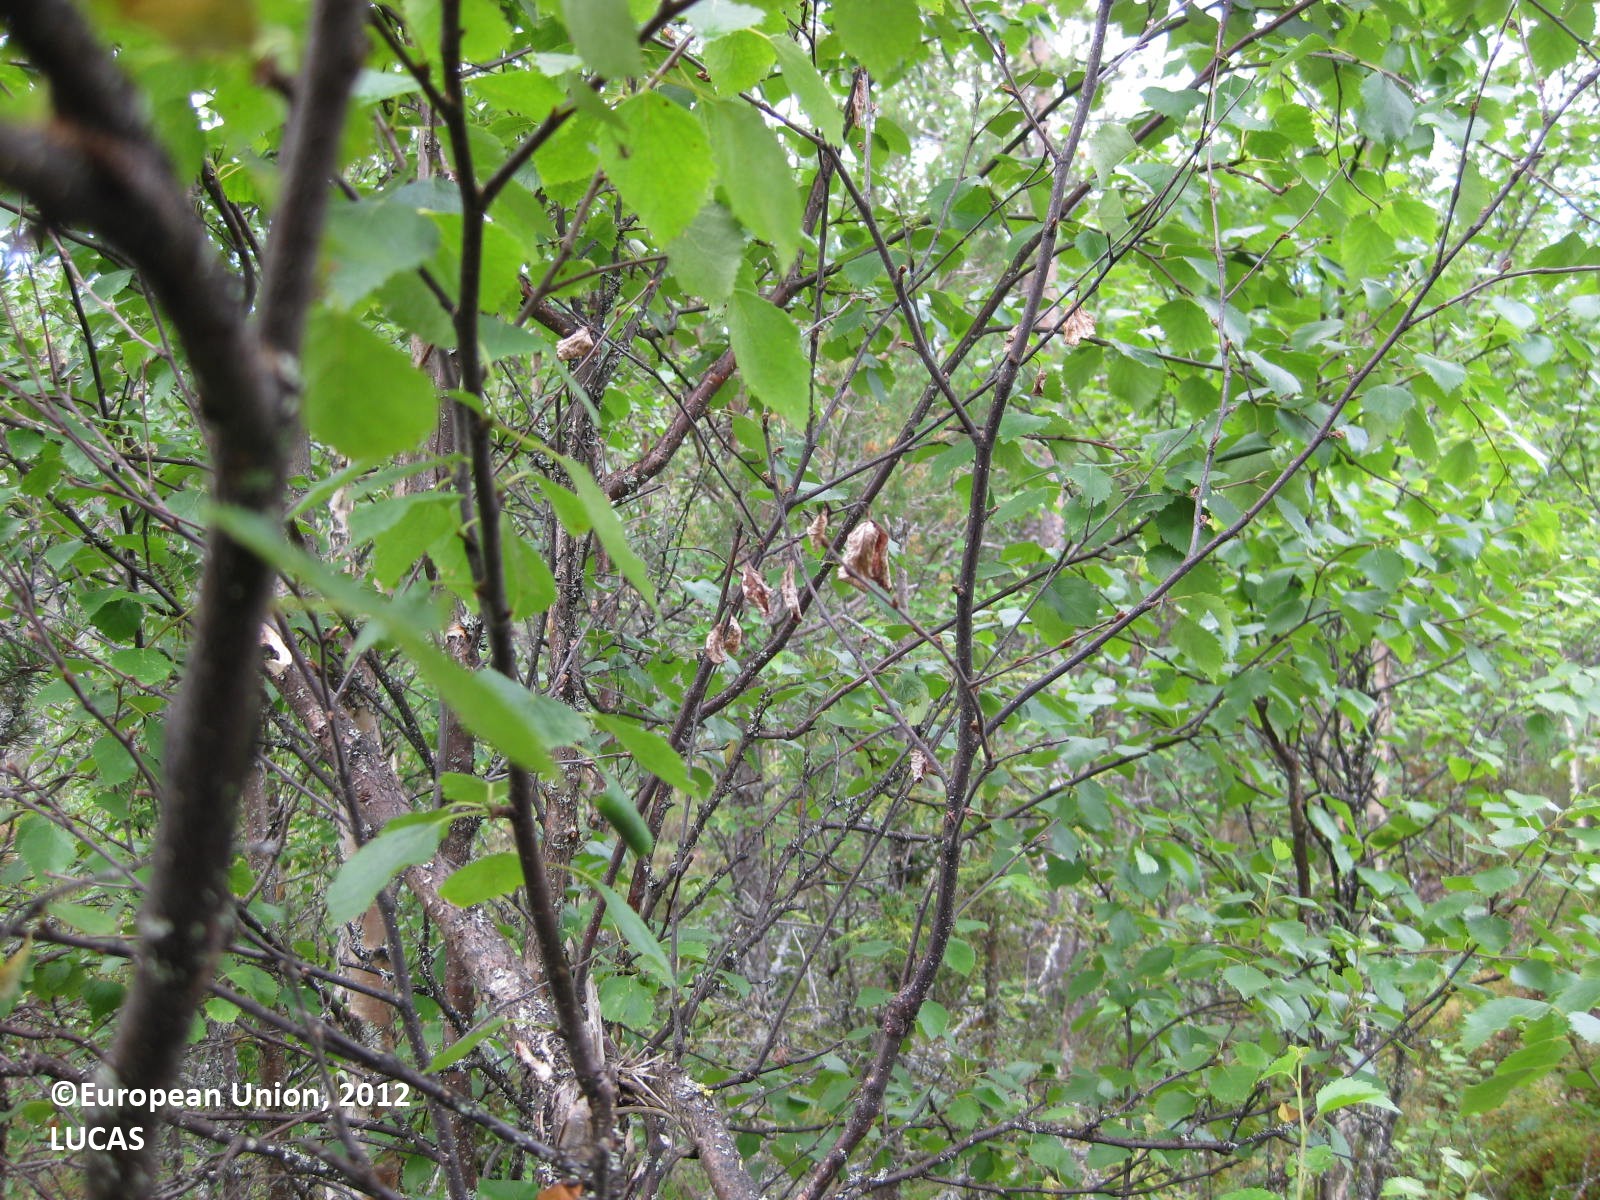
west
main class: Woodland
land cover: Pine dominated mixed woodland
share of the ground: > 75 %
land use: Forestry
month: July
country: FI
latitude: 65.7418
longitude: 29.3176
